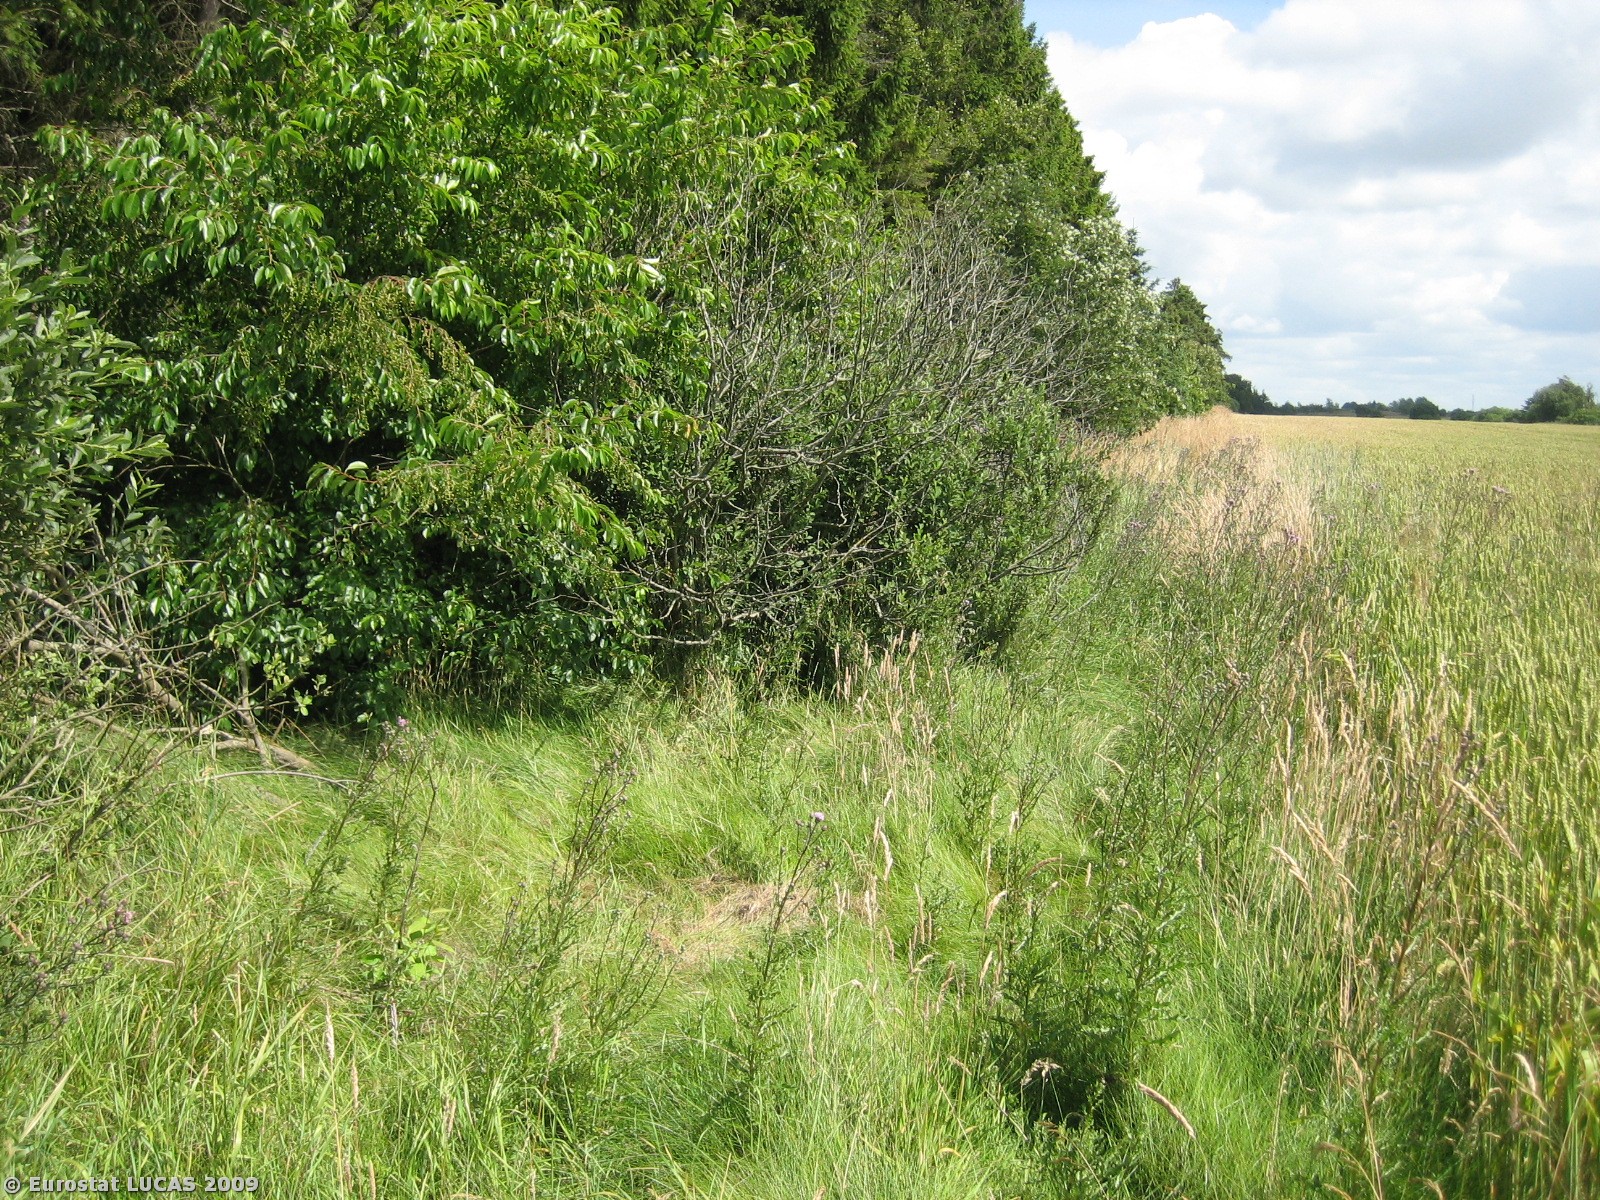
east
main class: Cropland
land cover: Common wheat
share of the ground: > 75 %
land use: Agriculture (excluding fallow land and kitchen gardens)
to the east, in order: Common wheat; Grass margins; Single bushes/trees; Common wheat
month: July
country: DK
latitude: 55.9098
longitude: 8.5457
